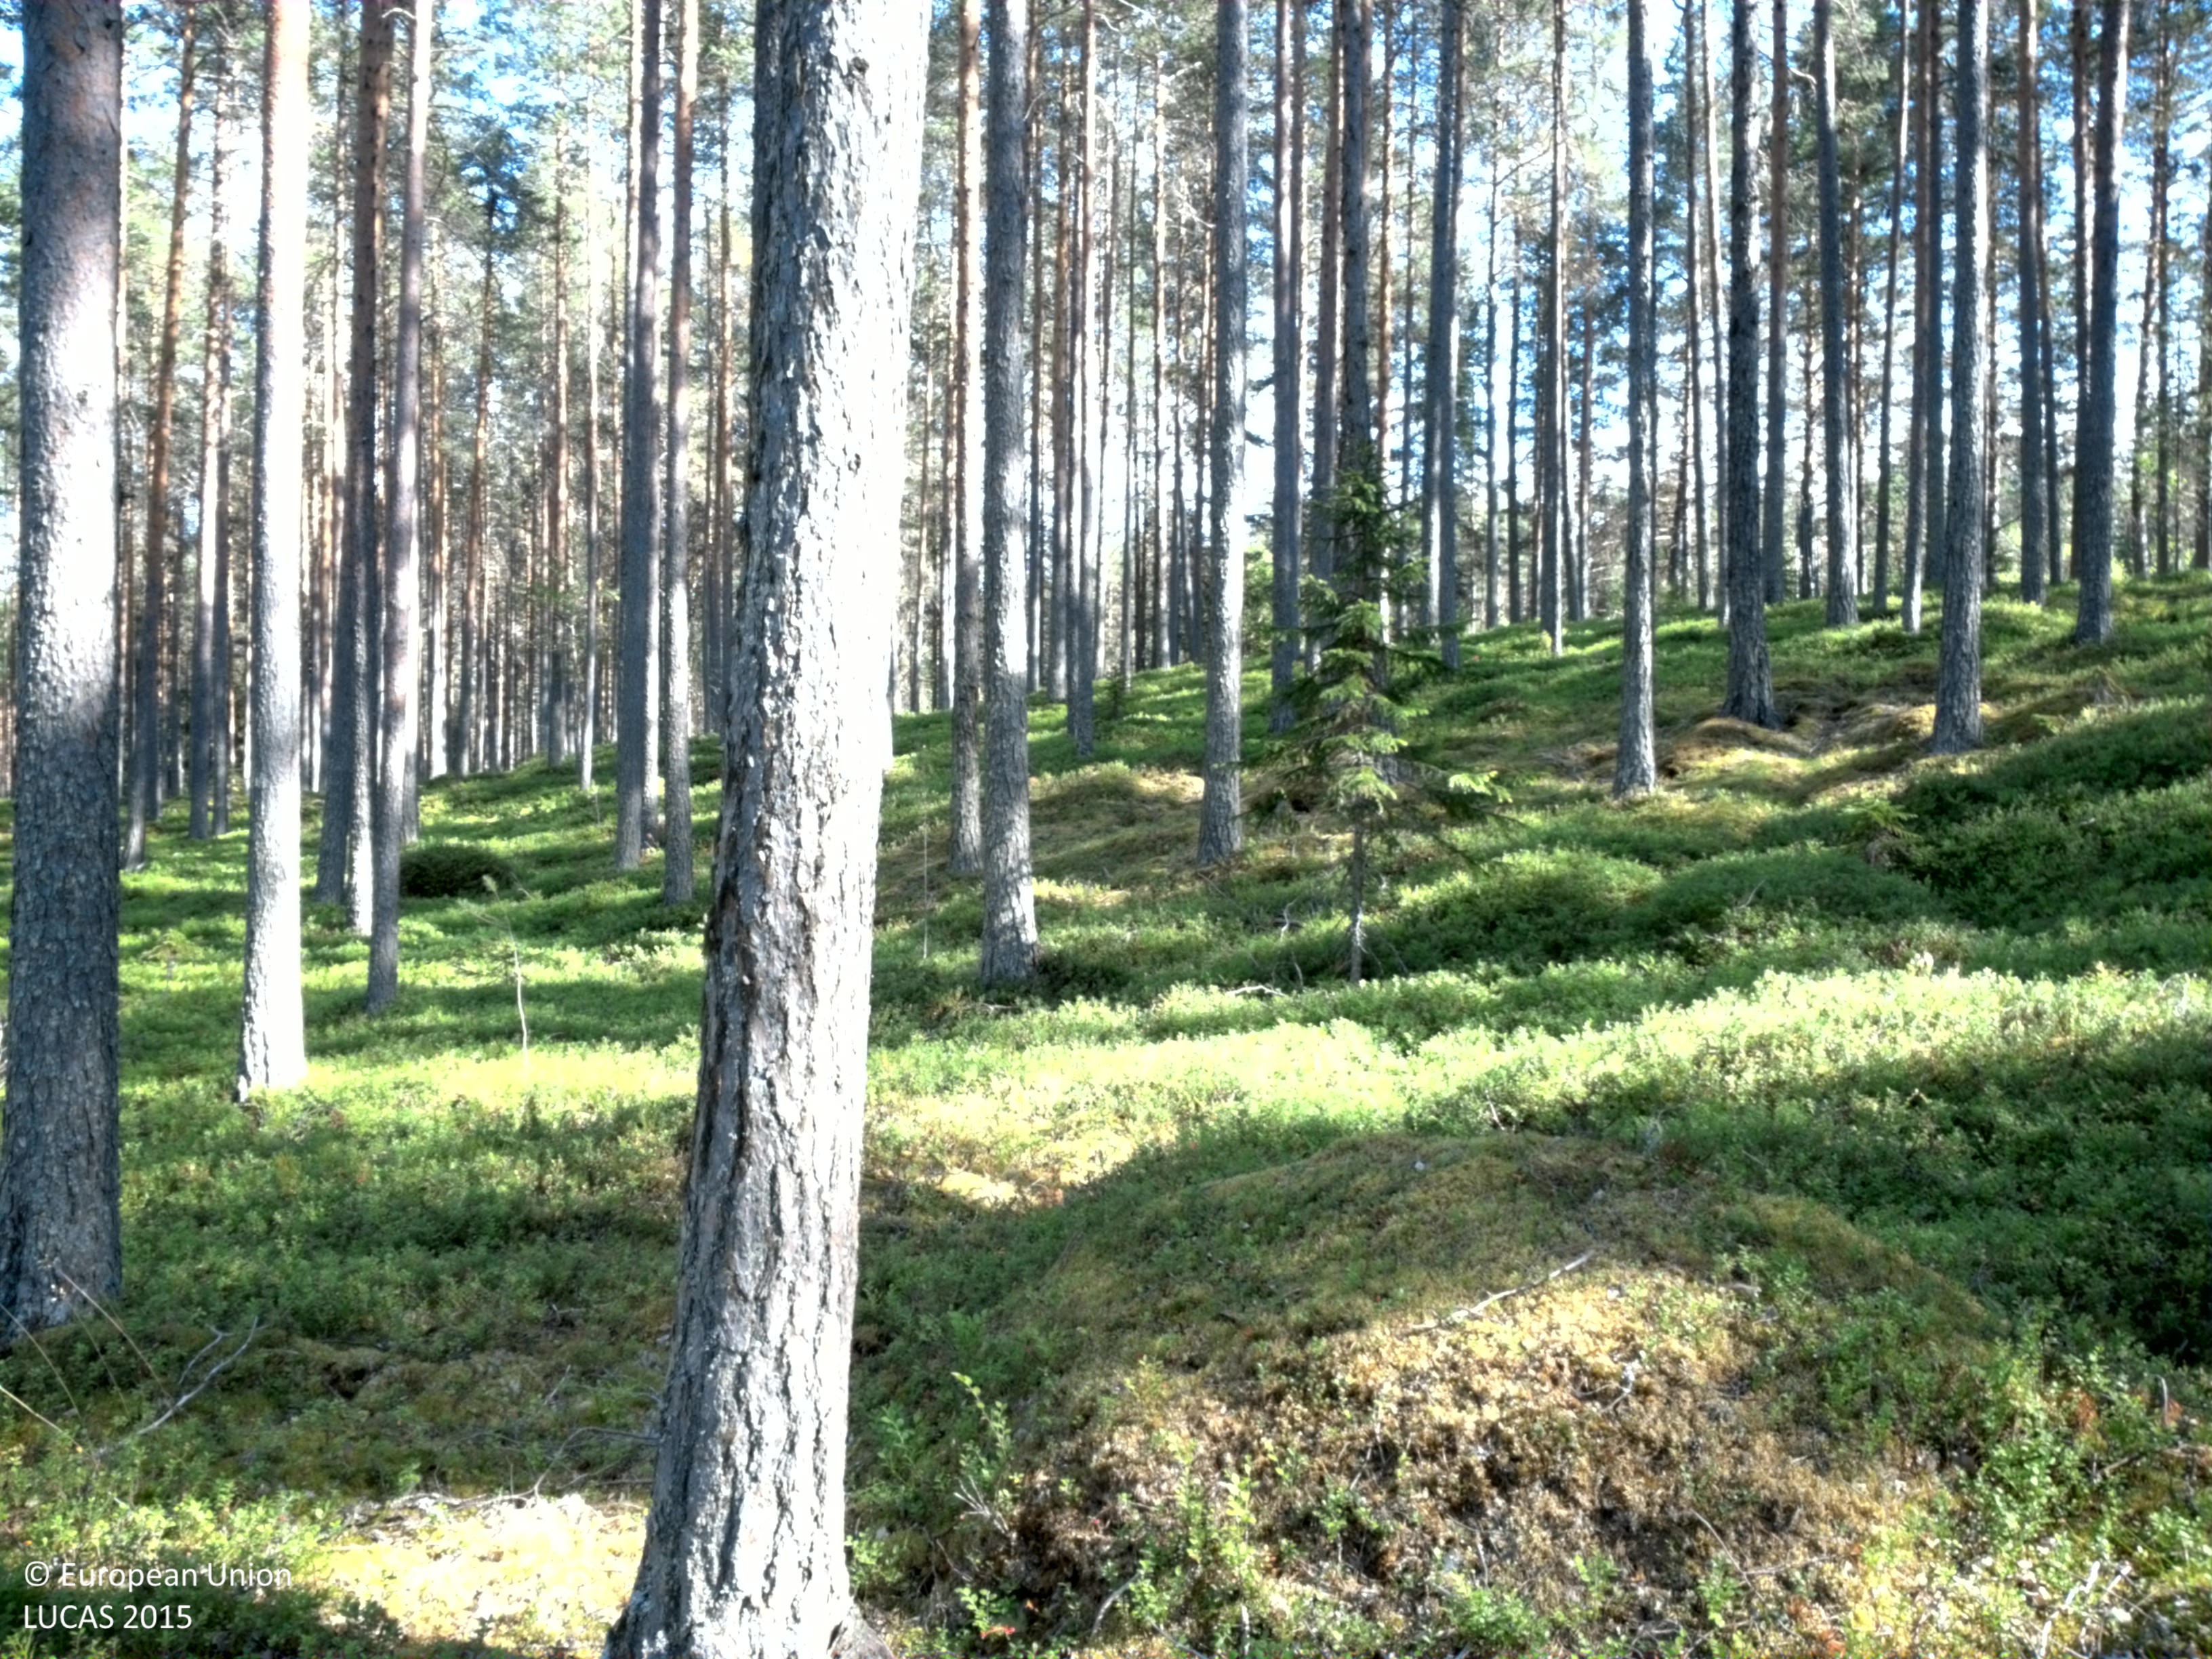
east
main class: Woodland
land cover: Pine dominated coniferous woodland
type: boreal forest
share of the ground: 50 - 75 %
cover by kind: coniferous forest trees 60 %, shrubs 20 %, lichens and mosses 20 %
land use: Forestry
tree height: > 5 m
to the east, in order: Pine dominated coniferous woodland; Tracks; Pine dominated coniferous woodland
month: August
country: SE
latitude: 64.5185
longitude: 18.7811
